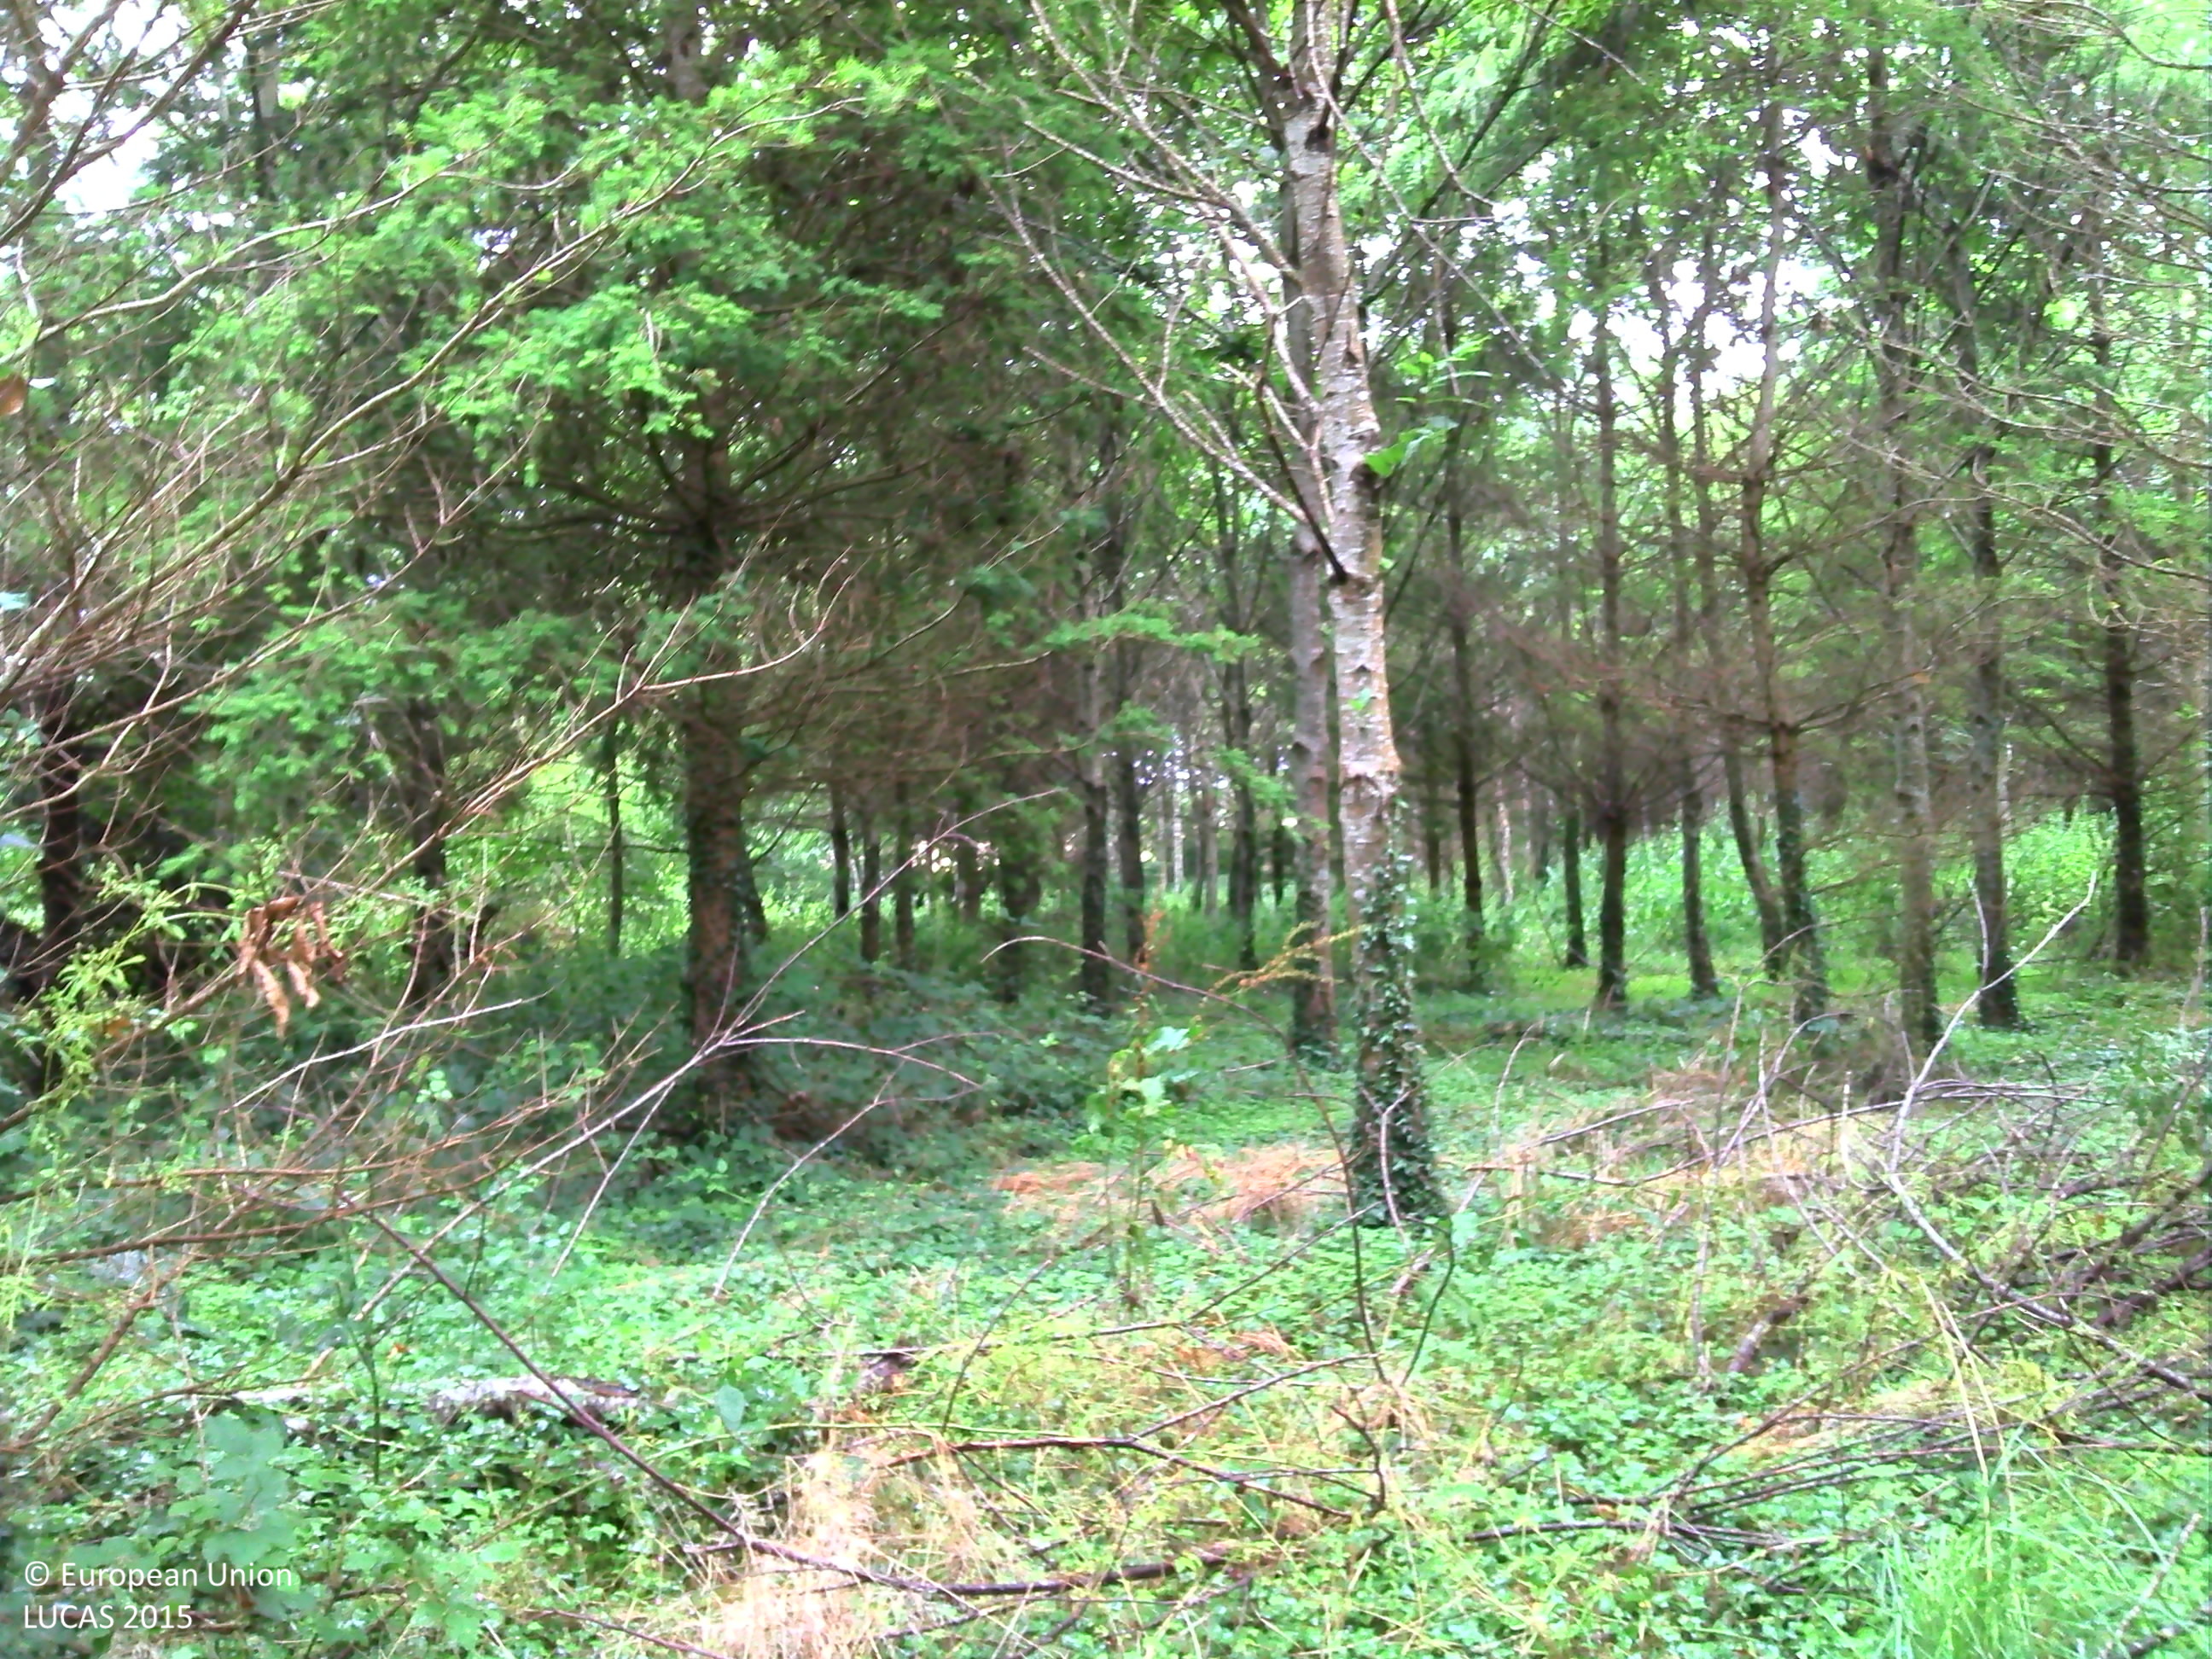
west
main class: Woodland
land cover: Spruce dominated mixed woodland
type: exotic forest
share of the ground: > 75 %
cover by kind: broadleaved forest trees 50 %, coniferous forest trees 25 %, shrubs 10 %, herbaceous plants 10 %, consolidated bare surface 5 %
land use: Forestry
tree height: > 5 m
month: July
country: FR
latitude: 47.9961
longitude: -3.6007
